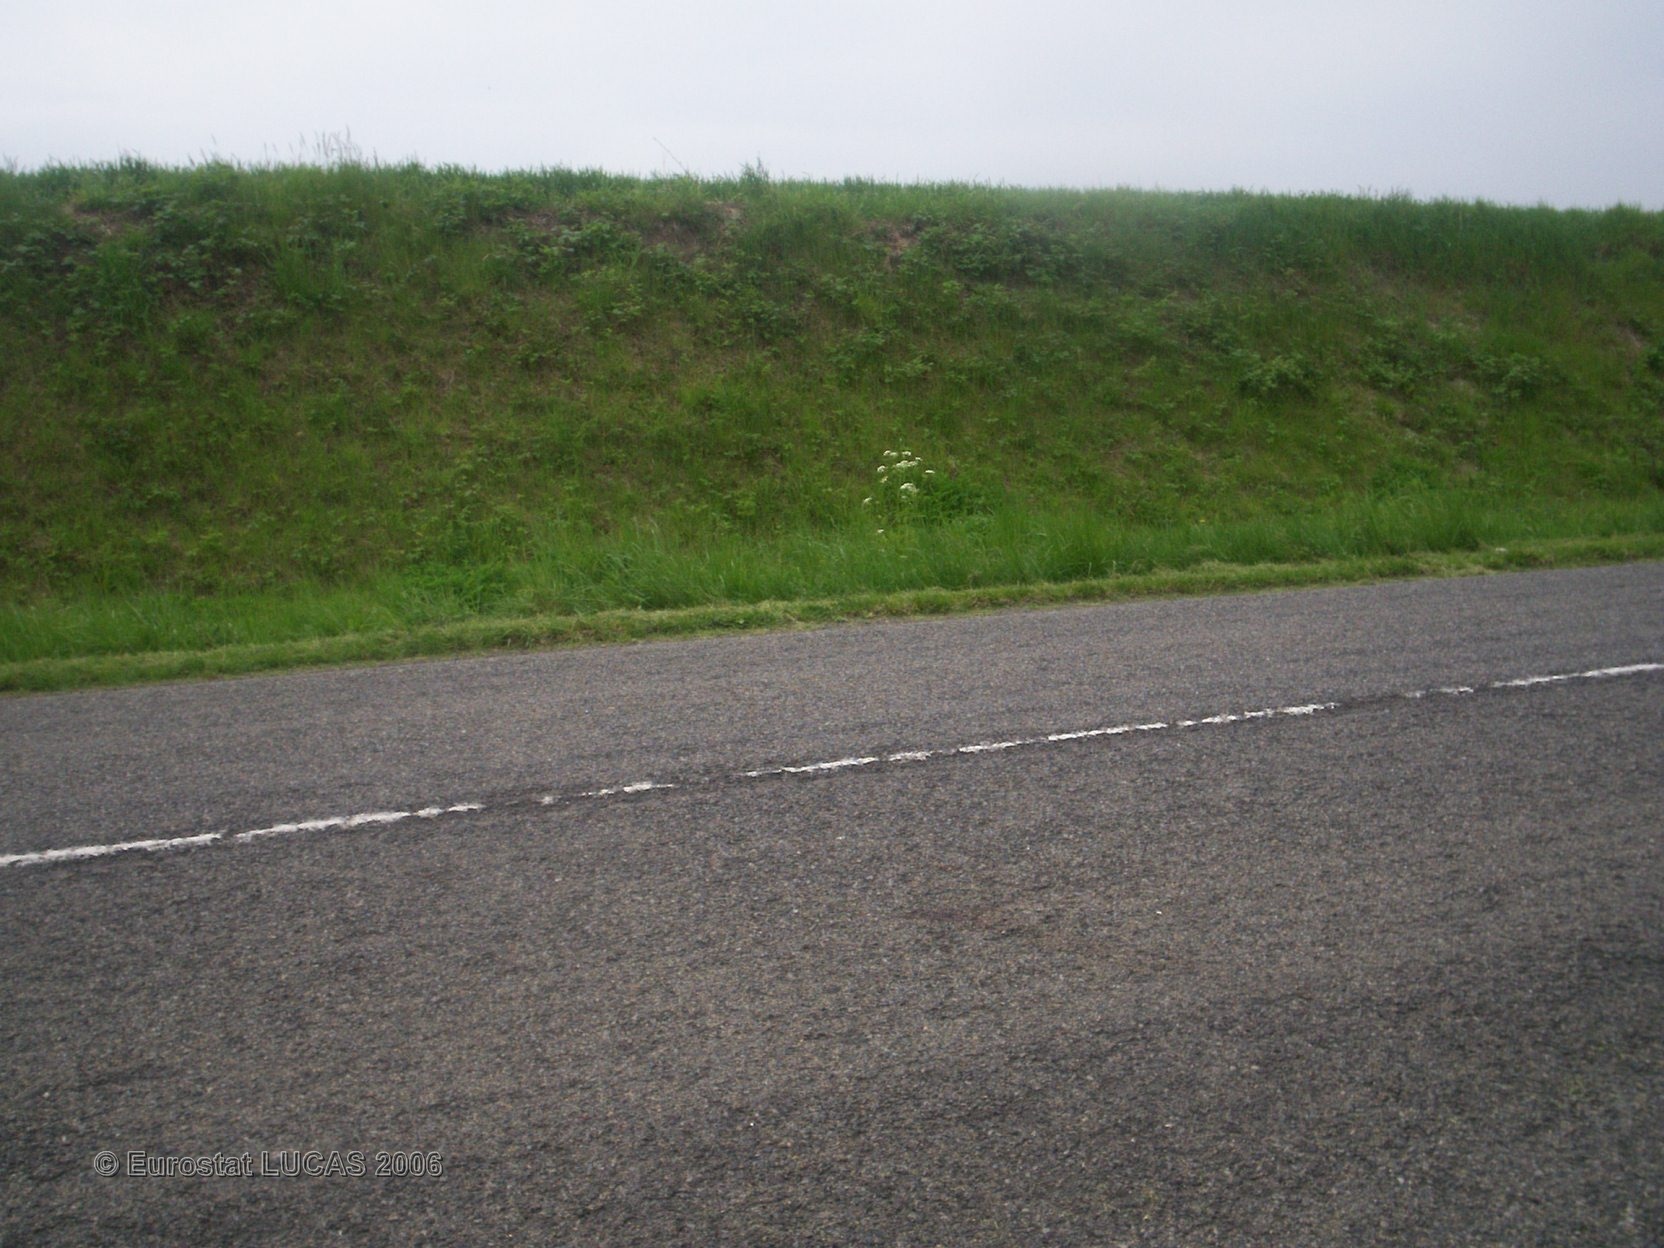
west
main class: Cropland
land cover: Common wheat
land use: Agriculture (excluding fallow land and kitchen gardens)
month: May
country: FR
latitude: 45.9931
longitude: 3.2472
